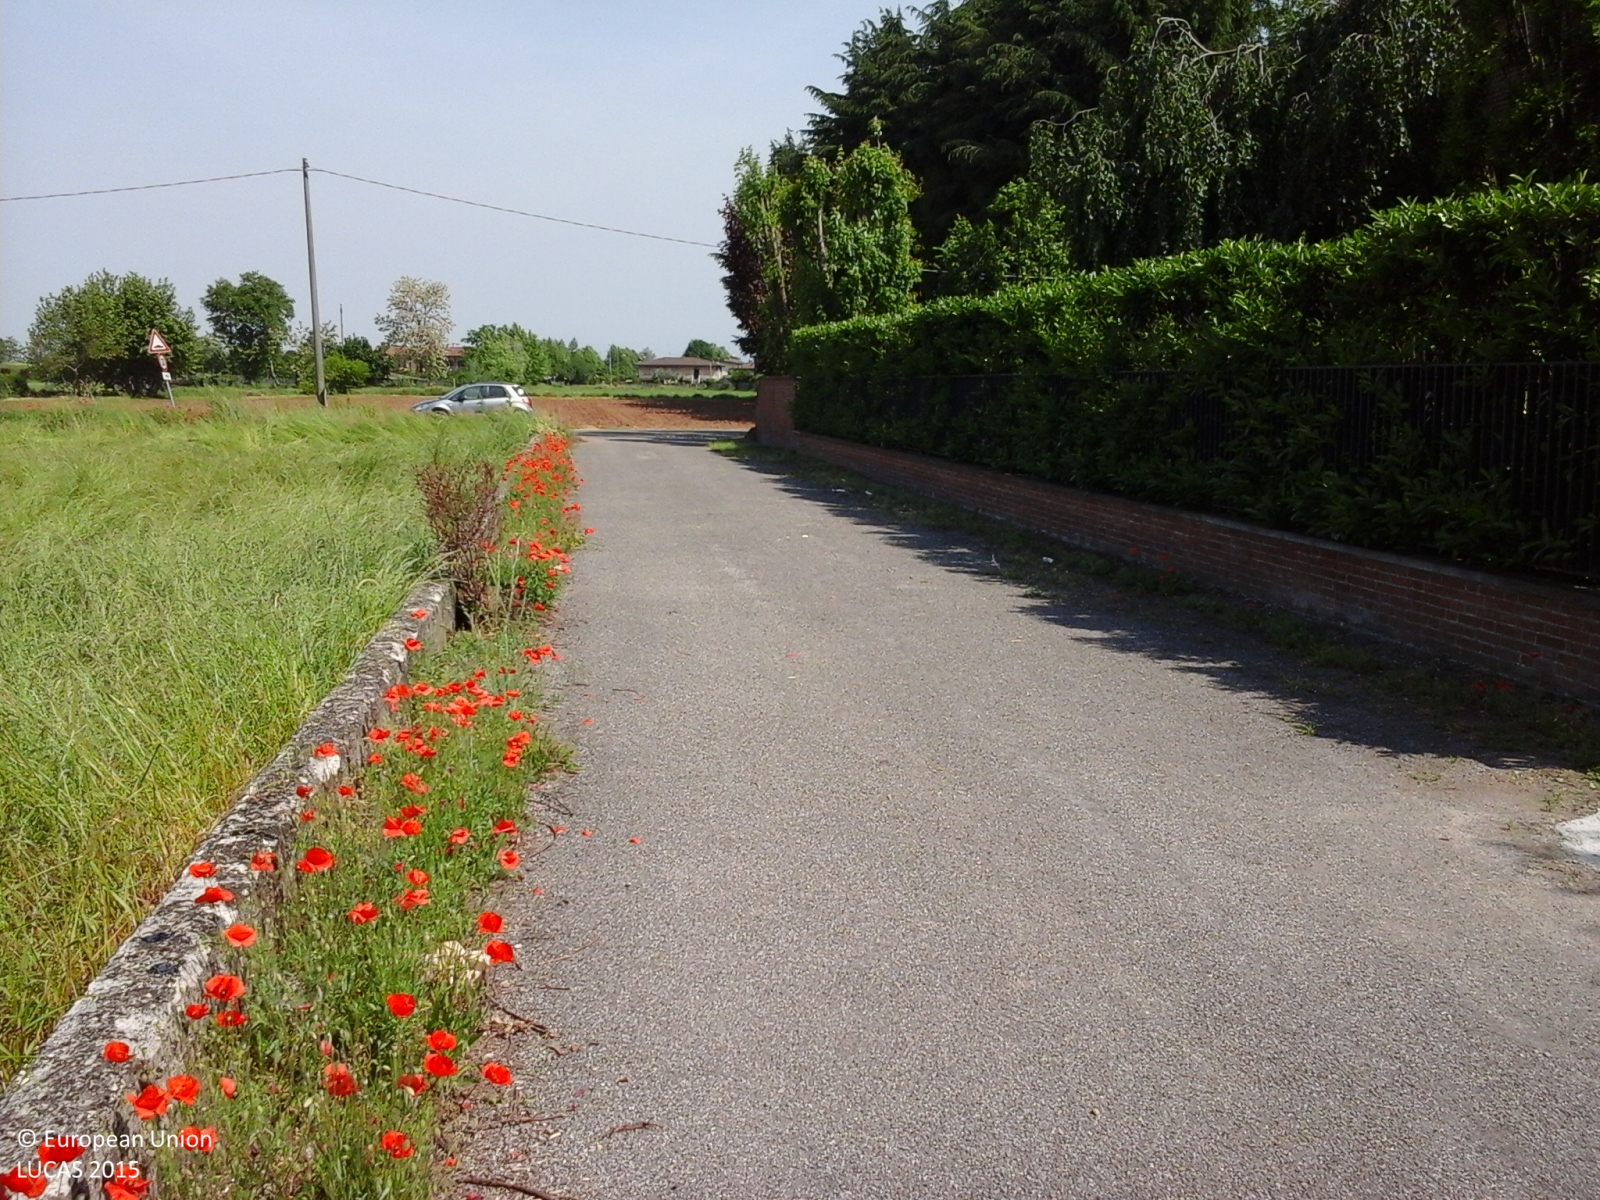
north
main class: Cropland
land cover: Temporary grasslands
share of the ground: > 75 %
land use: Agriculture (excluding fallow land and kitchen gardens)
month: May
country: IT
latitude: 45.3962
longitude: 9.8597
